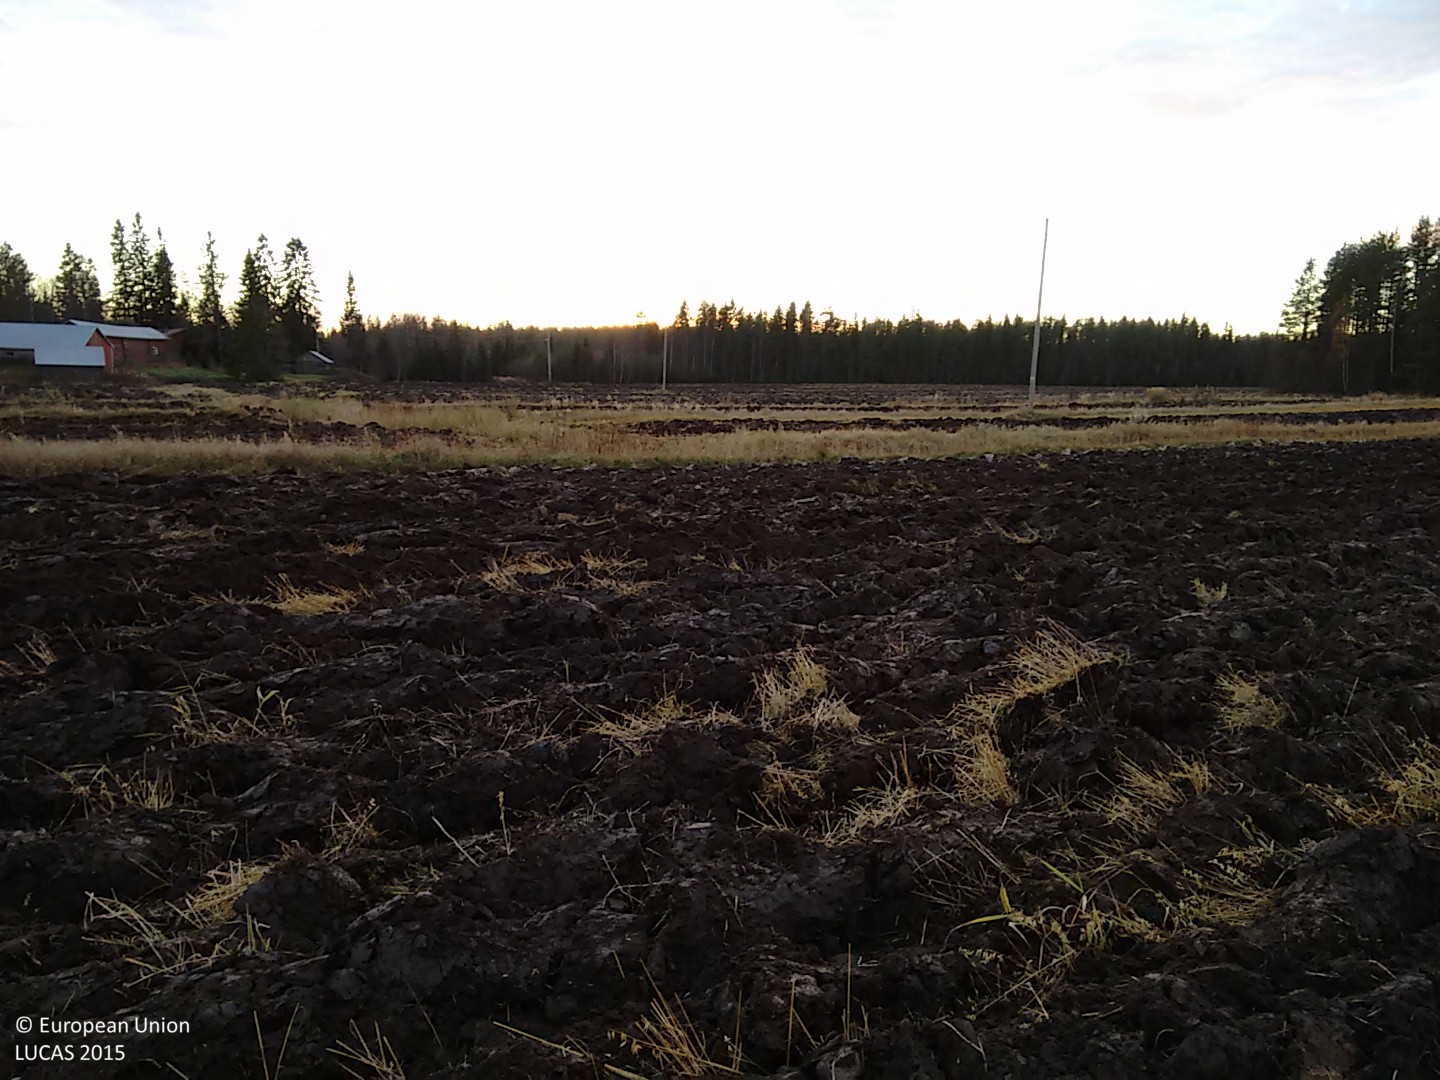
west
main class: Cropland
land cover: Oats
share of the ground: < 10 %
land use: Agriculture (excluding fallow land and kitchen gardens)
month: October
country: FI
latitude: 64.6350
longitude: 24.6530
